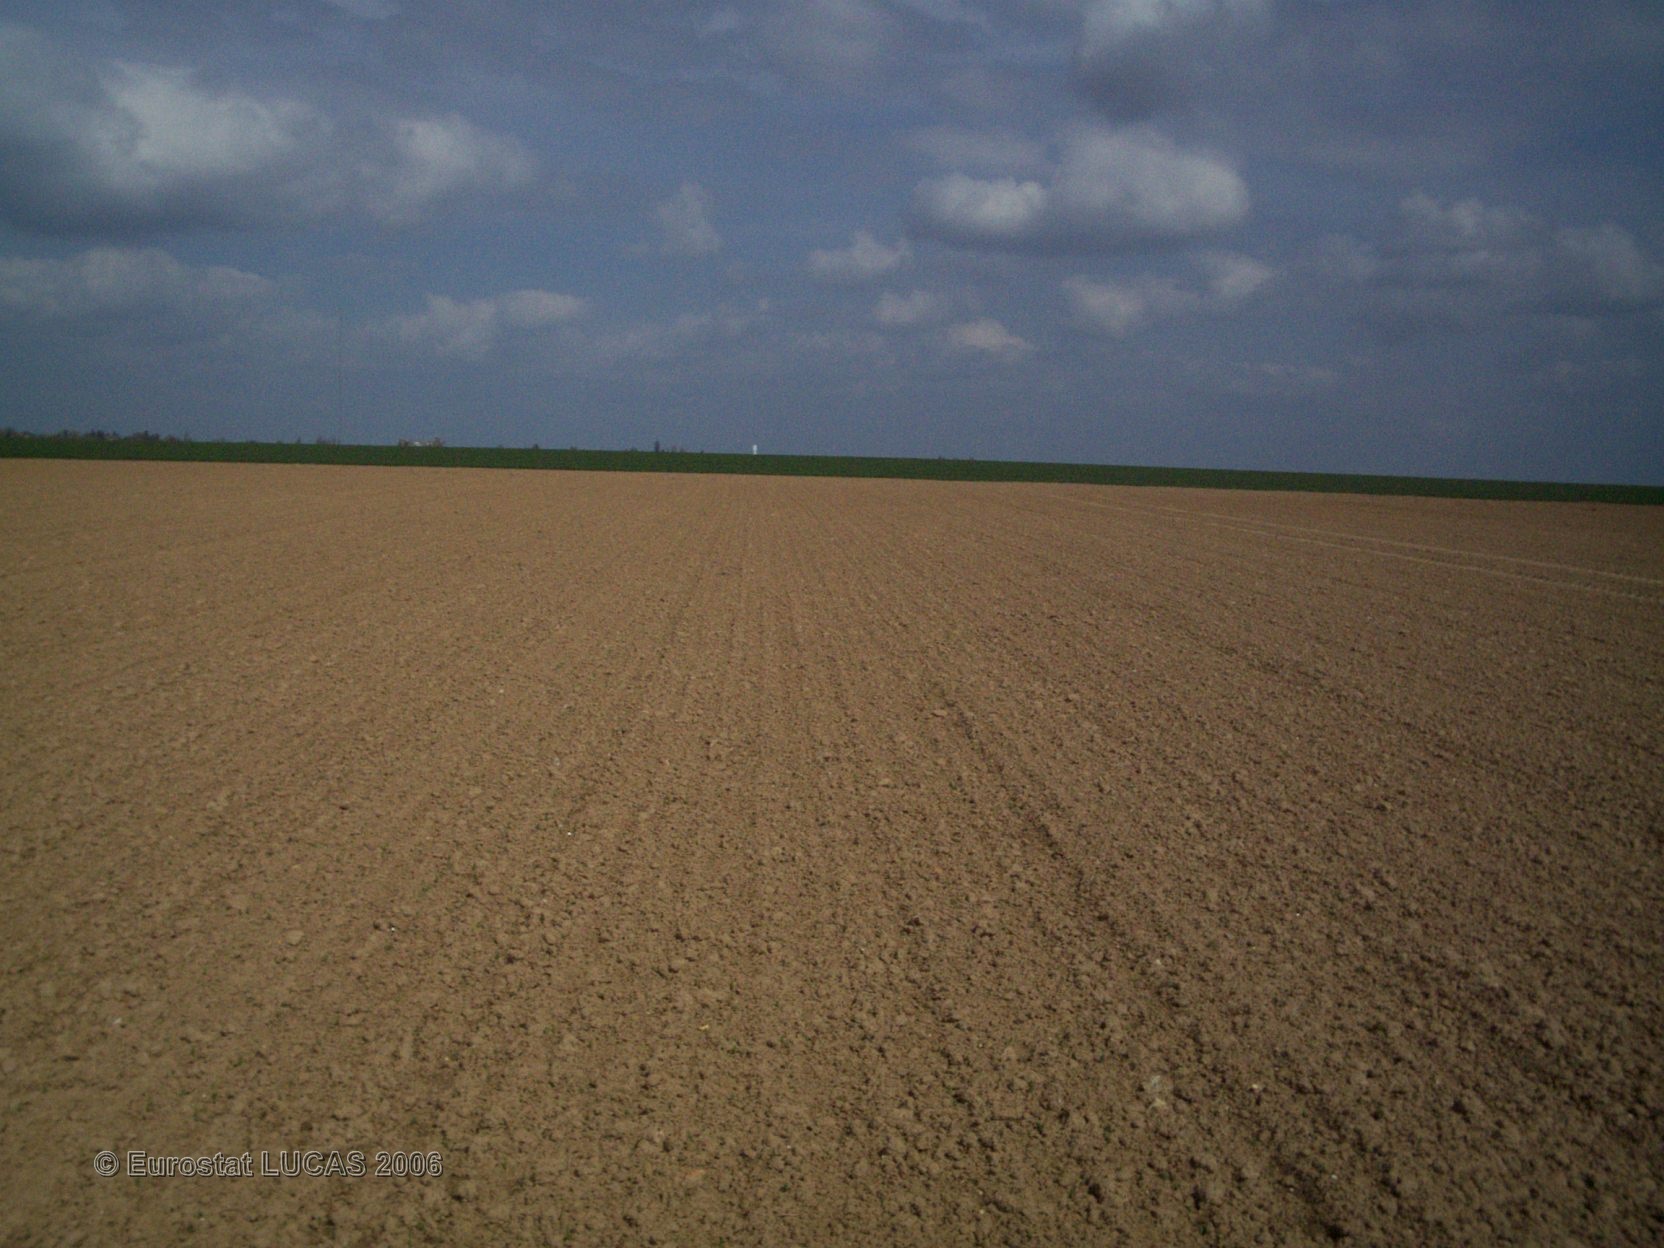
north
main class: Cropland
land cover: Dry pulses
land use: Agriculture (excluding fallow land and kitchen gardens)
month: April
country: FR
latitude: 49.0865
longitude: 1.0097
